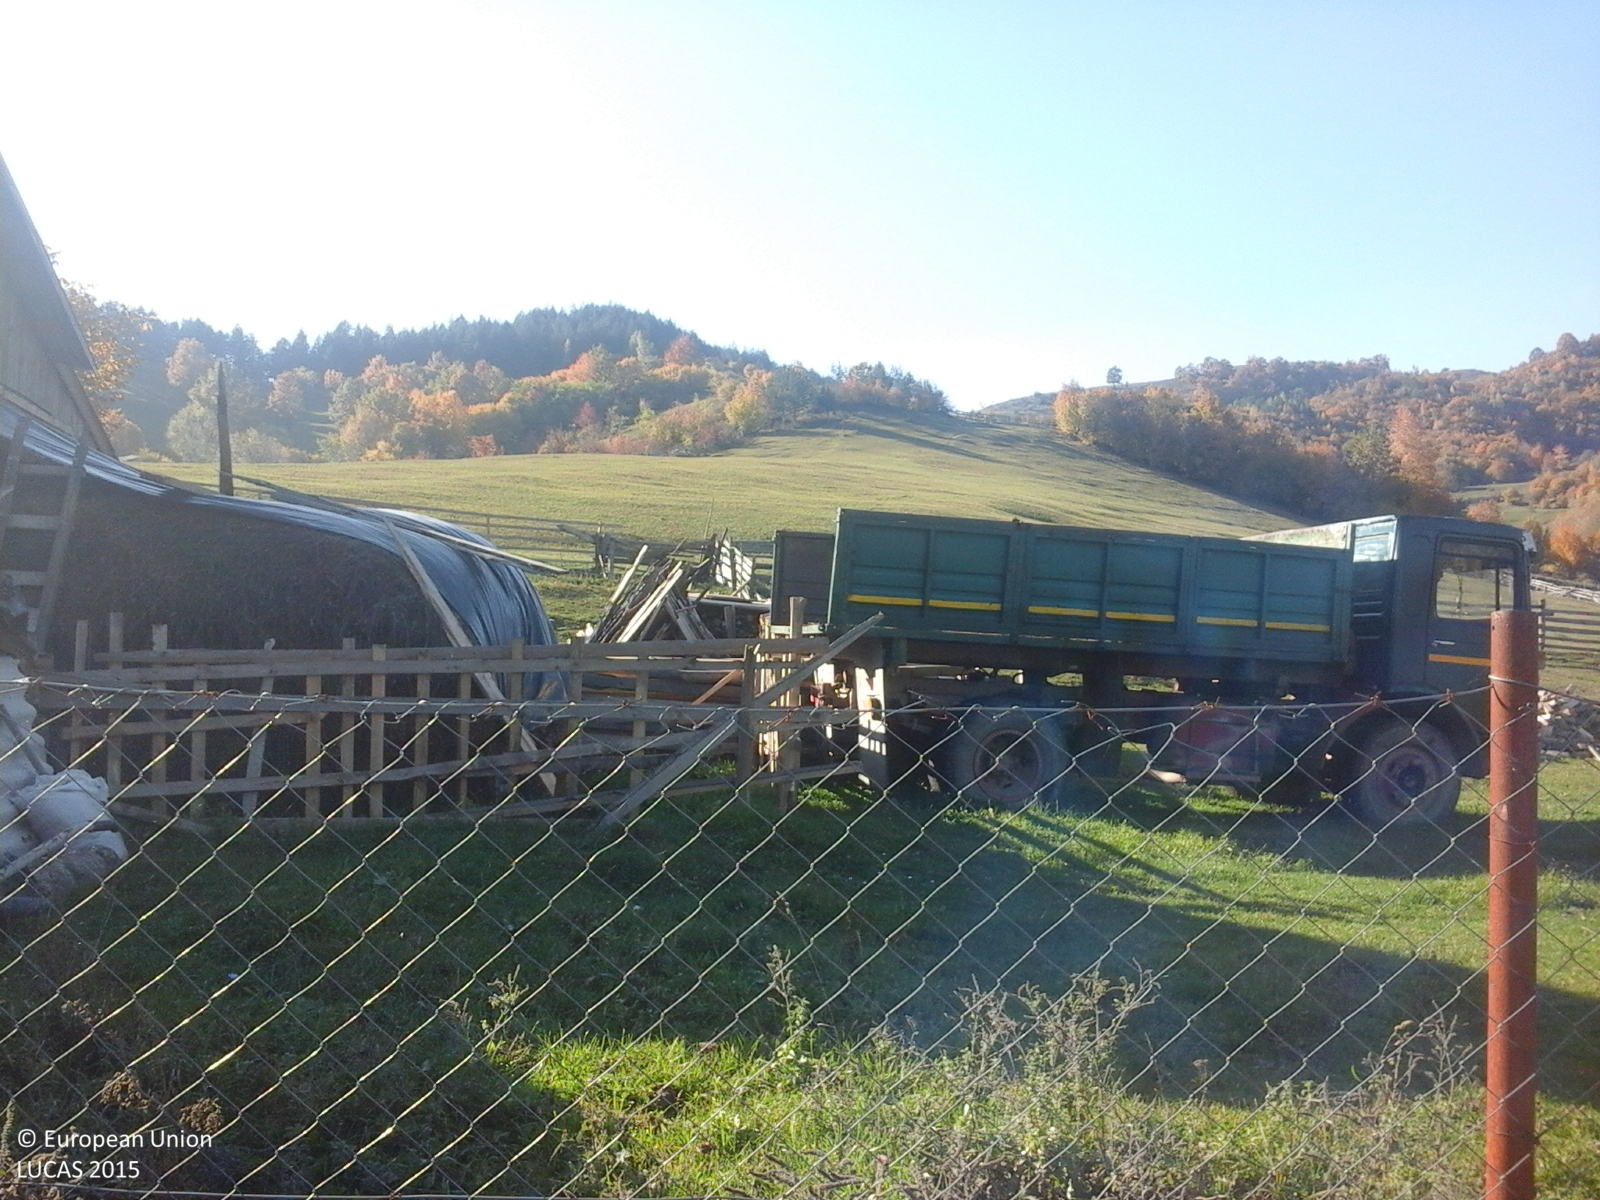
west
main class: Grassland
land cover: Grassland without tree/shrub cover
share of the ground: > 75 %
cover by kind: herbaceous plants 100 %
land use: Residential
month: October
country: RO
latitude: 45.9301
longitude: 26.6800
